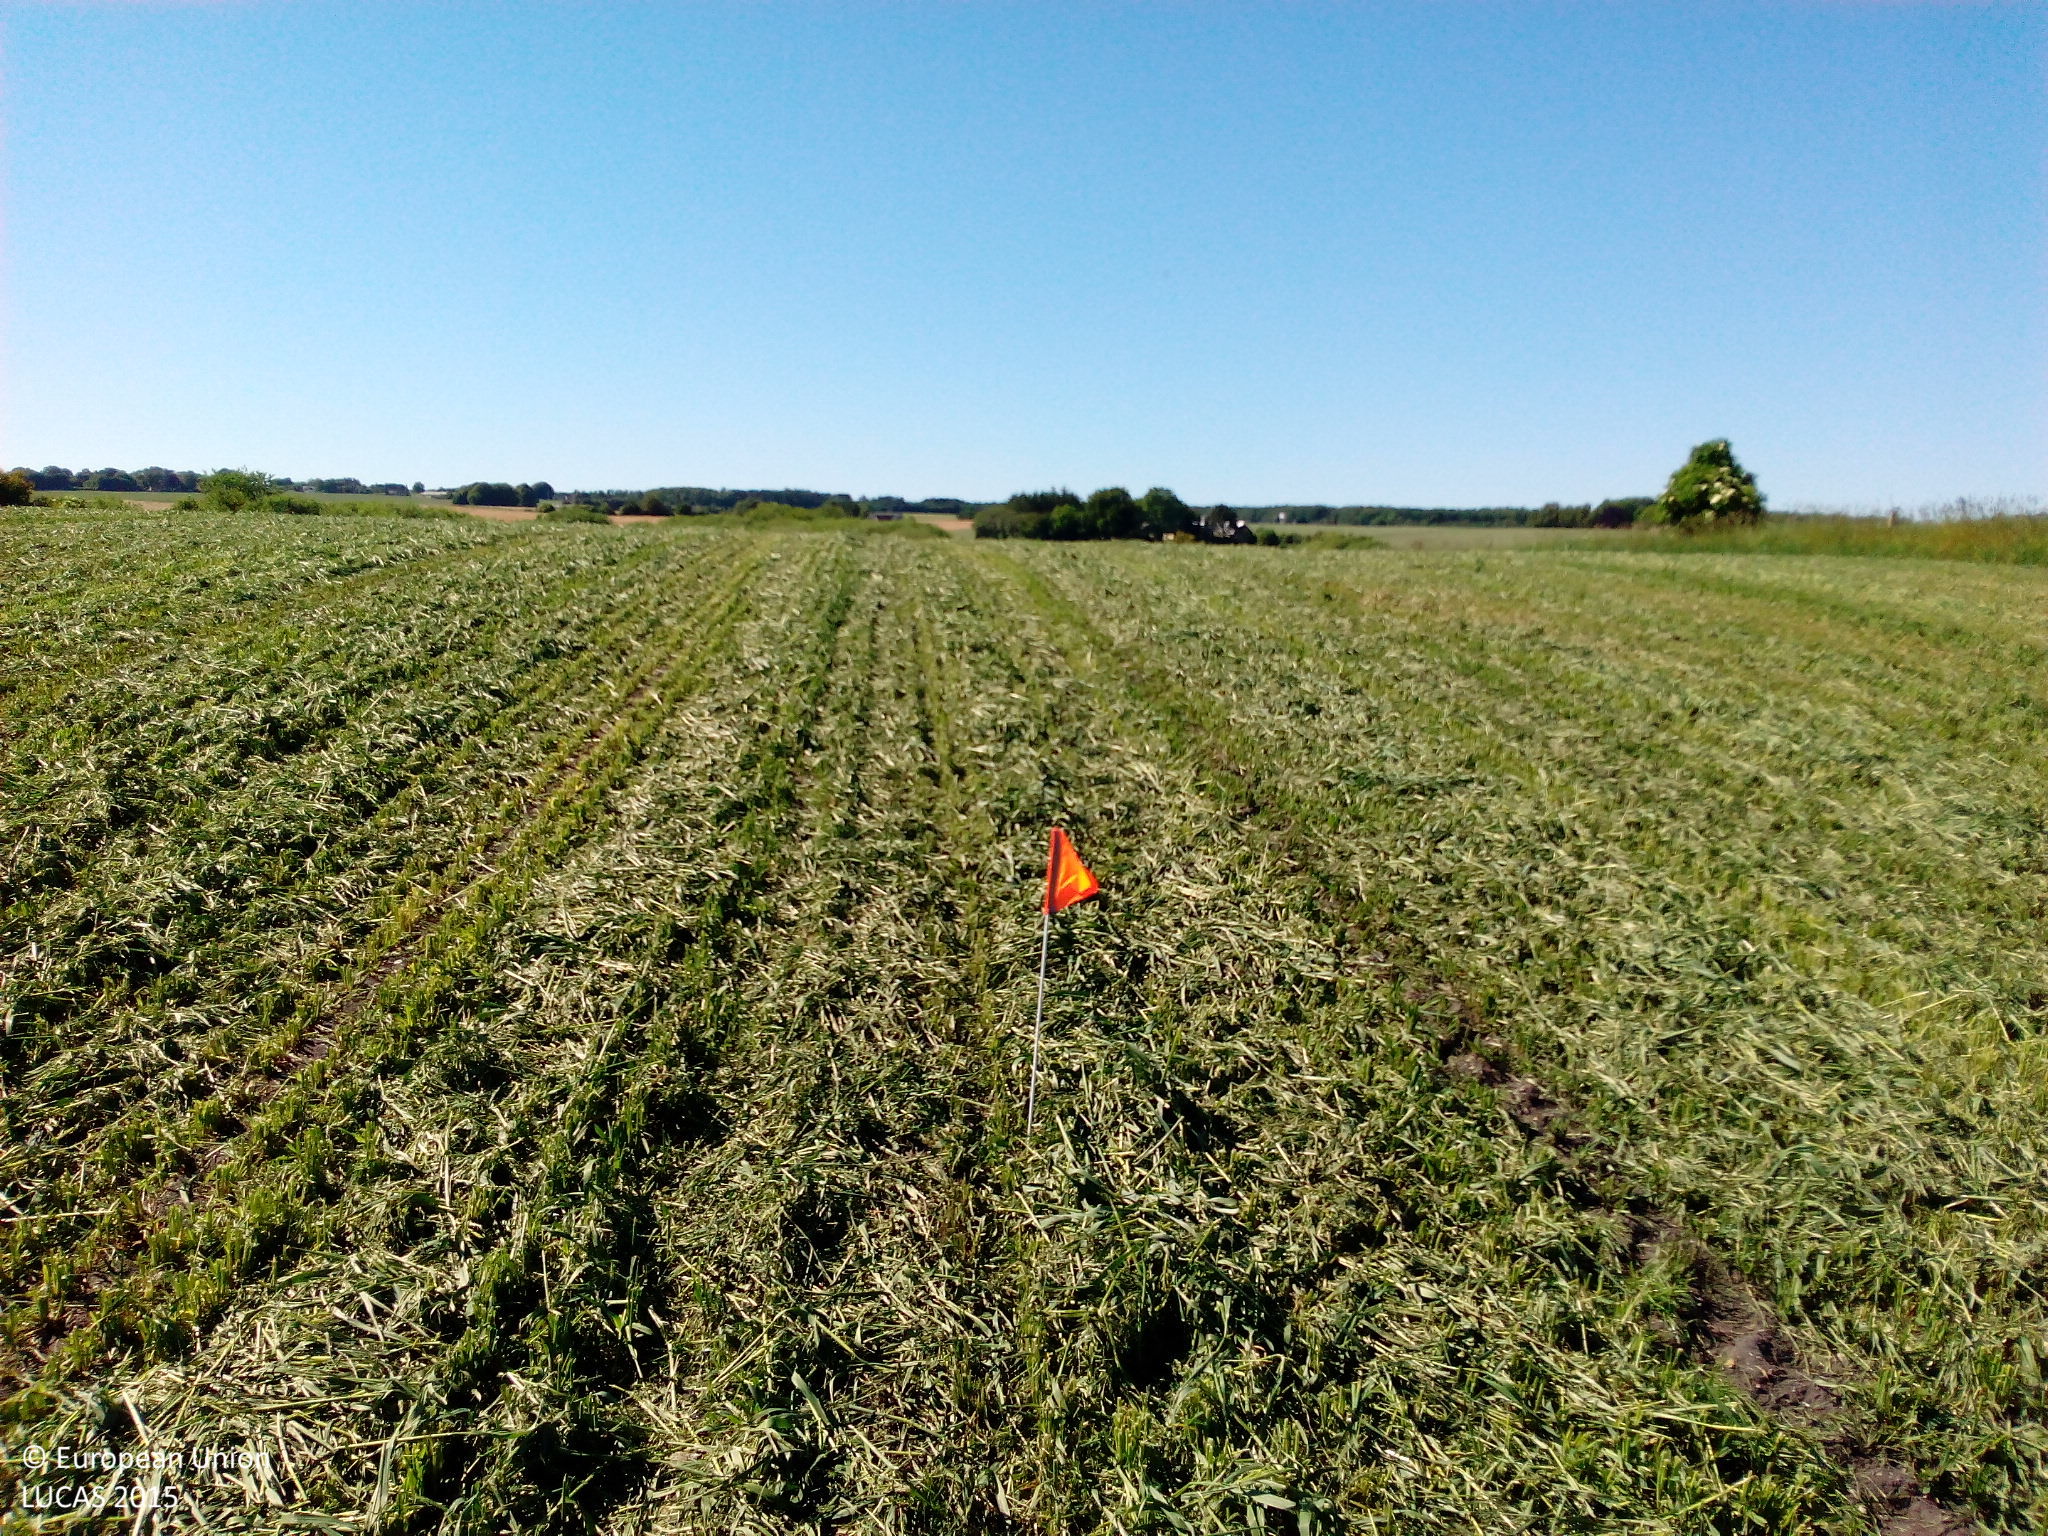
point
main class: Cropland
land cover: Mixed cereals for fodder
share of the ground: 50 - 75 %
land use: Agriculture (excluding fallow land and kitchen gardens)
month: July
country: DK
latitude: 56.4727
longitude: 10.8269
